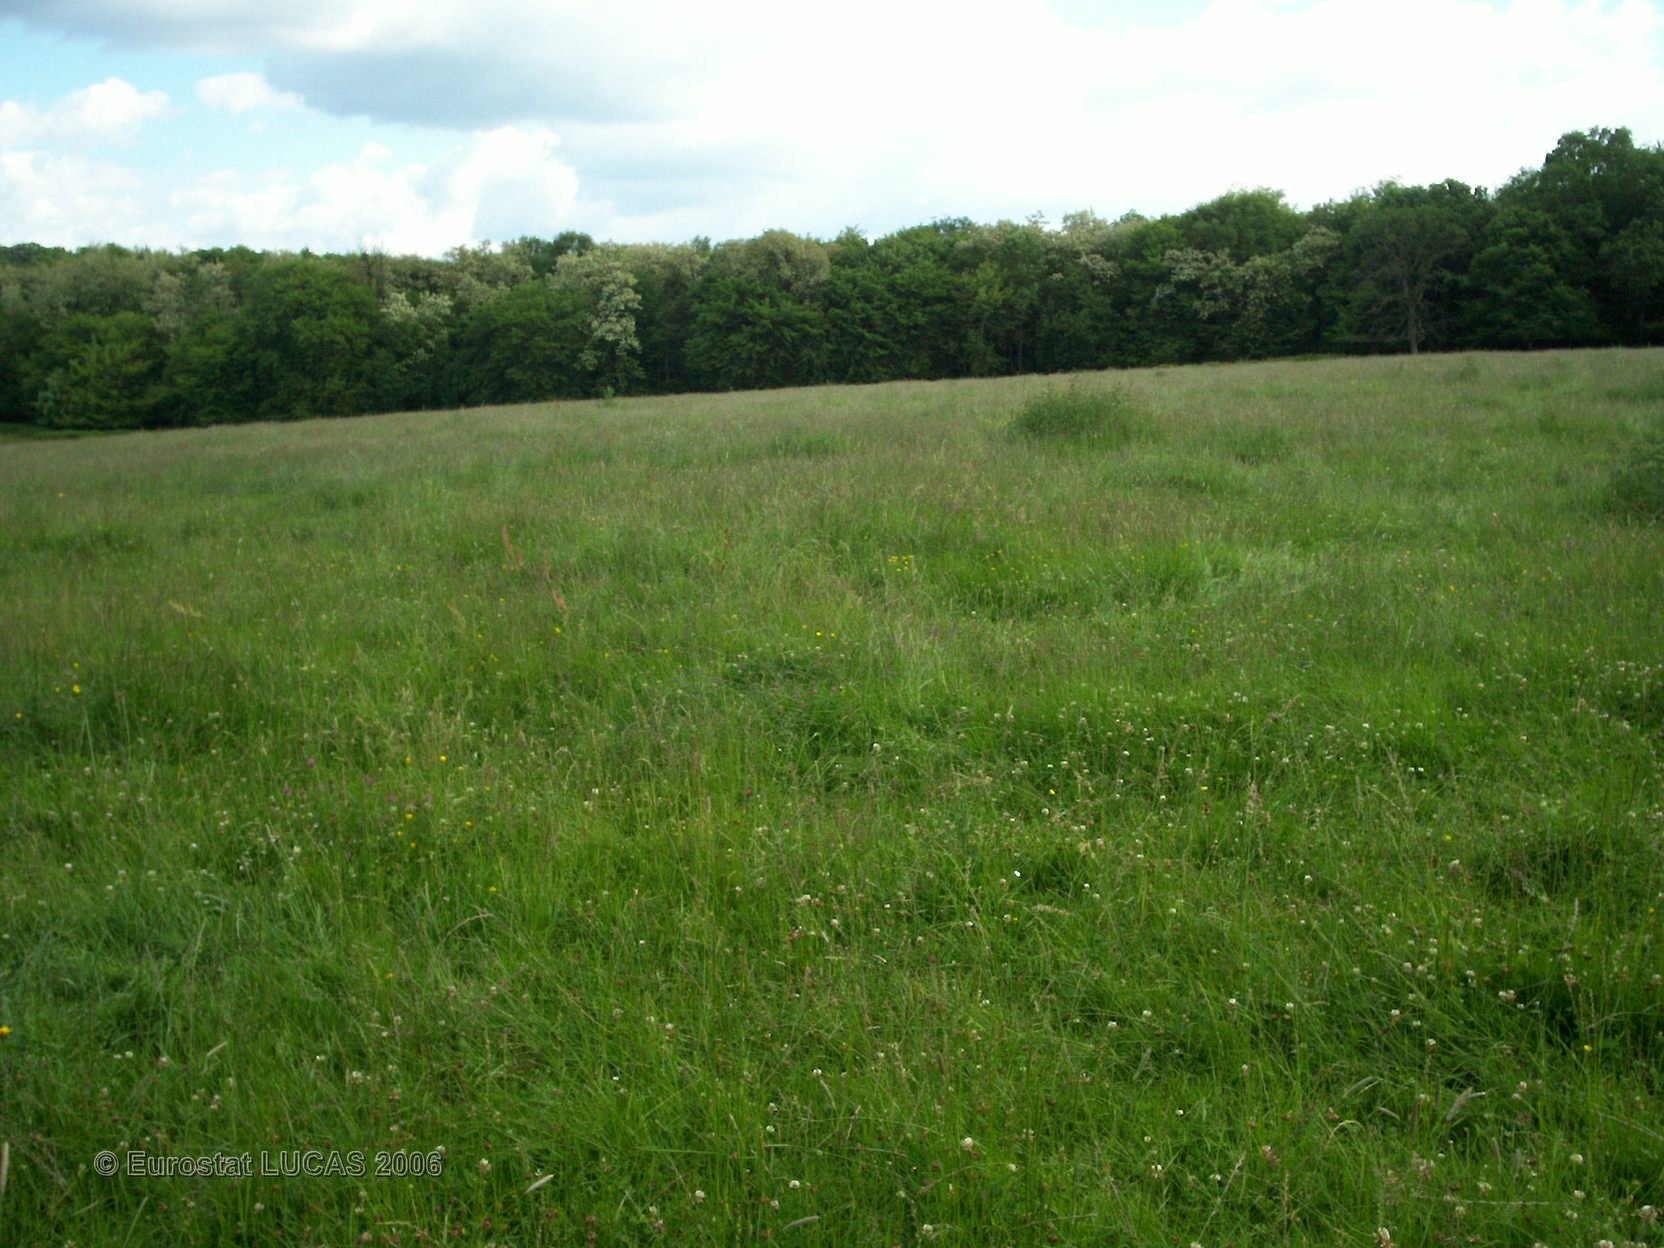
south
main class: Grassland
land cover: Grassland without tree/shrub cover
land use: Agriculture (excluding fallow land and kitchen gardens)
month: June
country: FR
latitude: 47.0439
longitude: 3.0066
